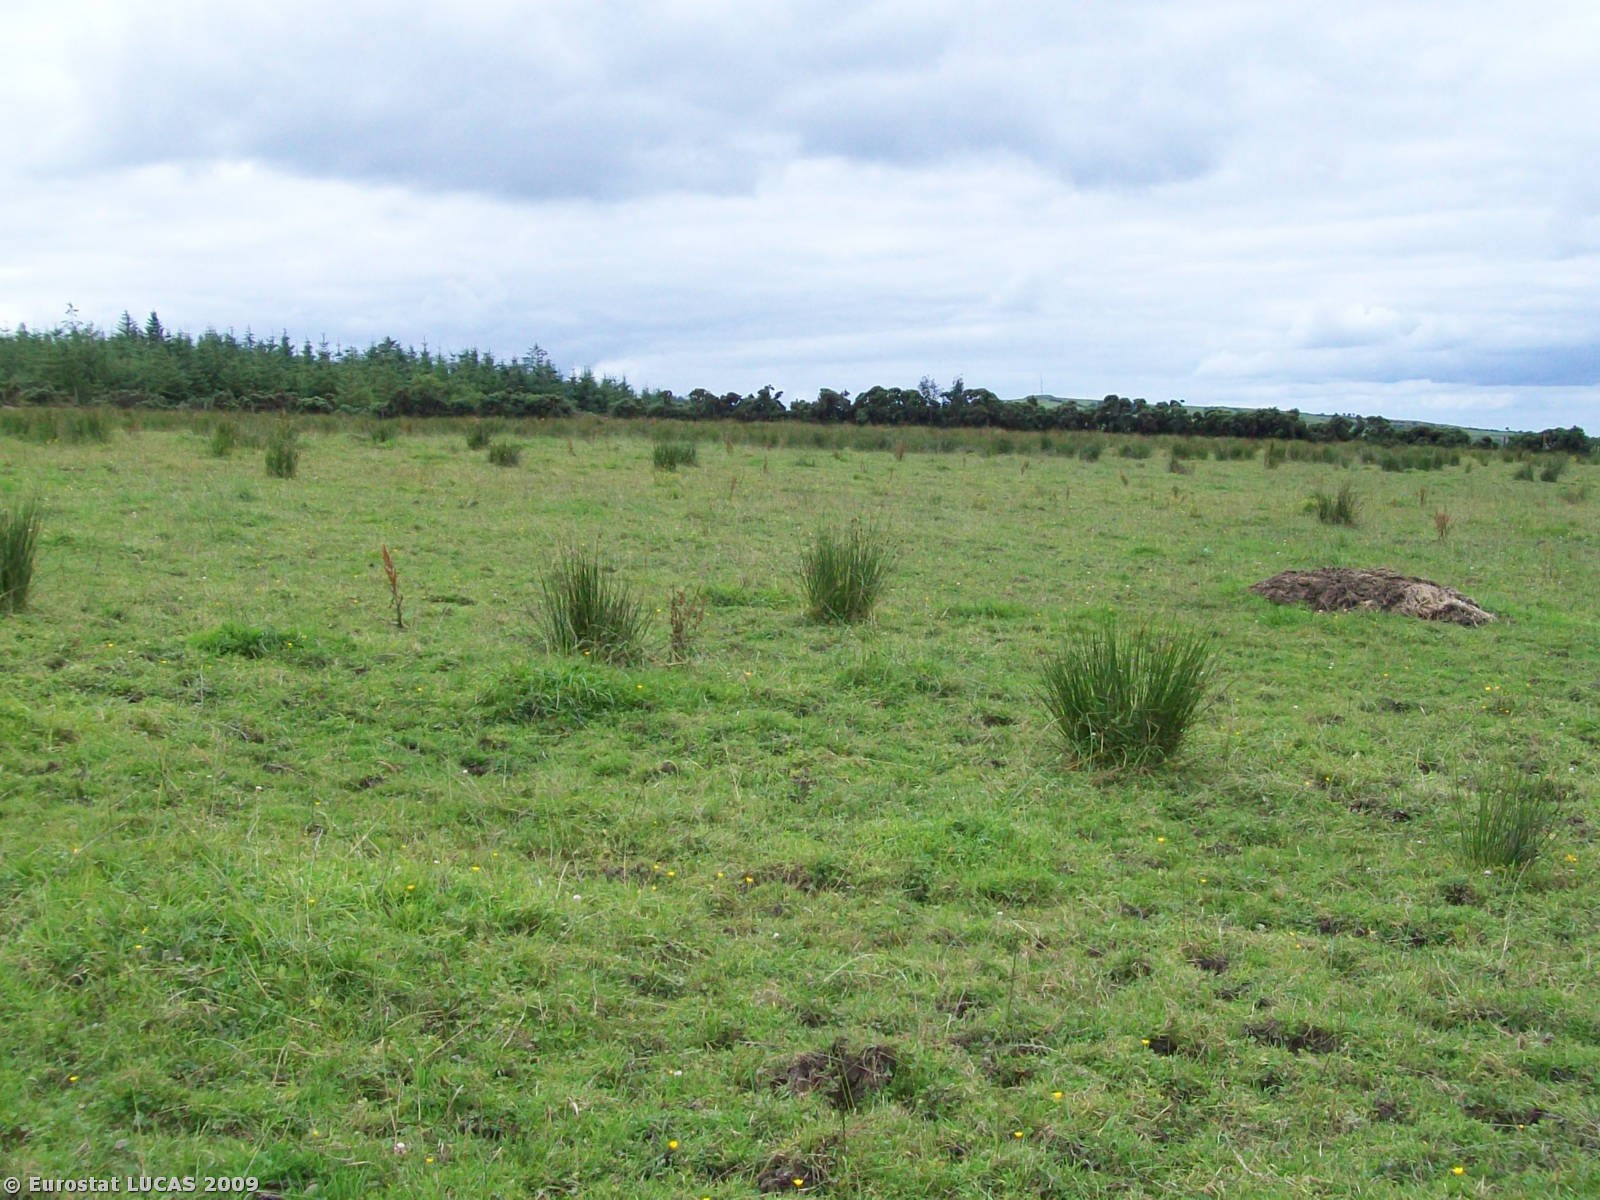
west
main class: Grassland
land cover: Grassland without tree/shrub cover
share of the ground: > 75 %
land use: Agriculture (excluding fallow land and kitchen gardens)
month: August
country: GB
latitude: 54.2491
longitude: -6.5957
